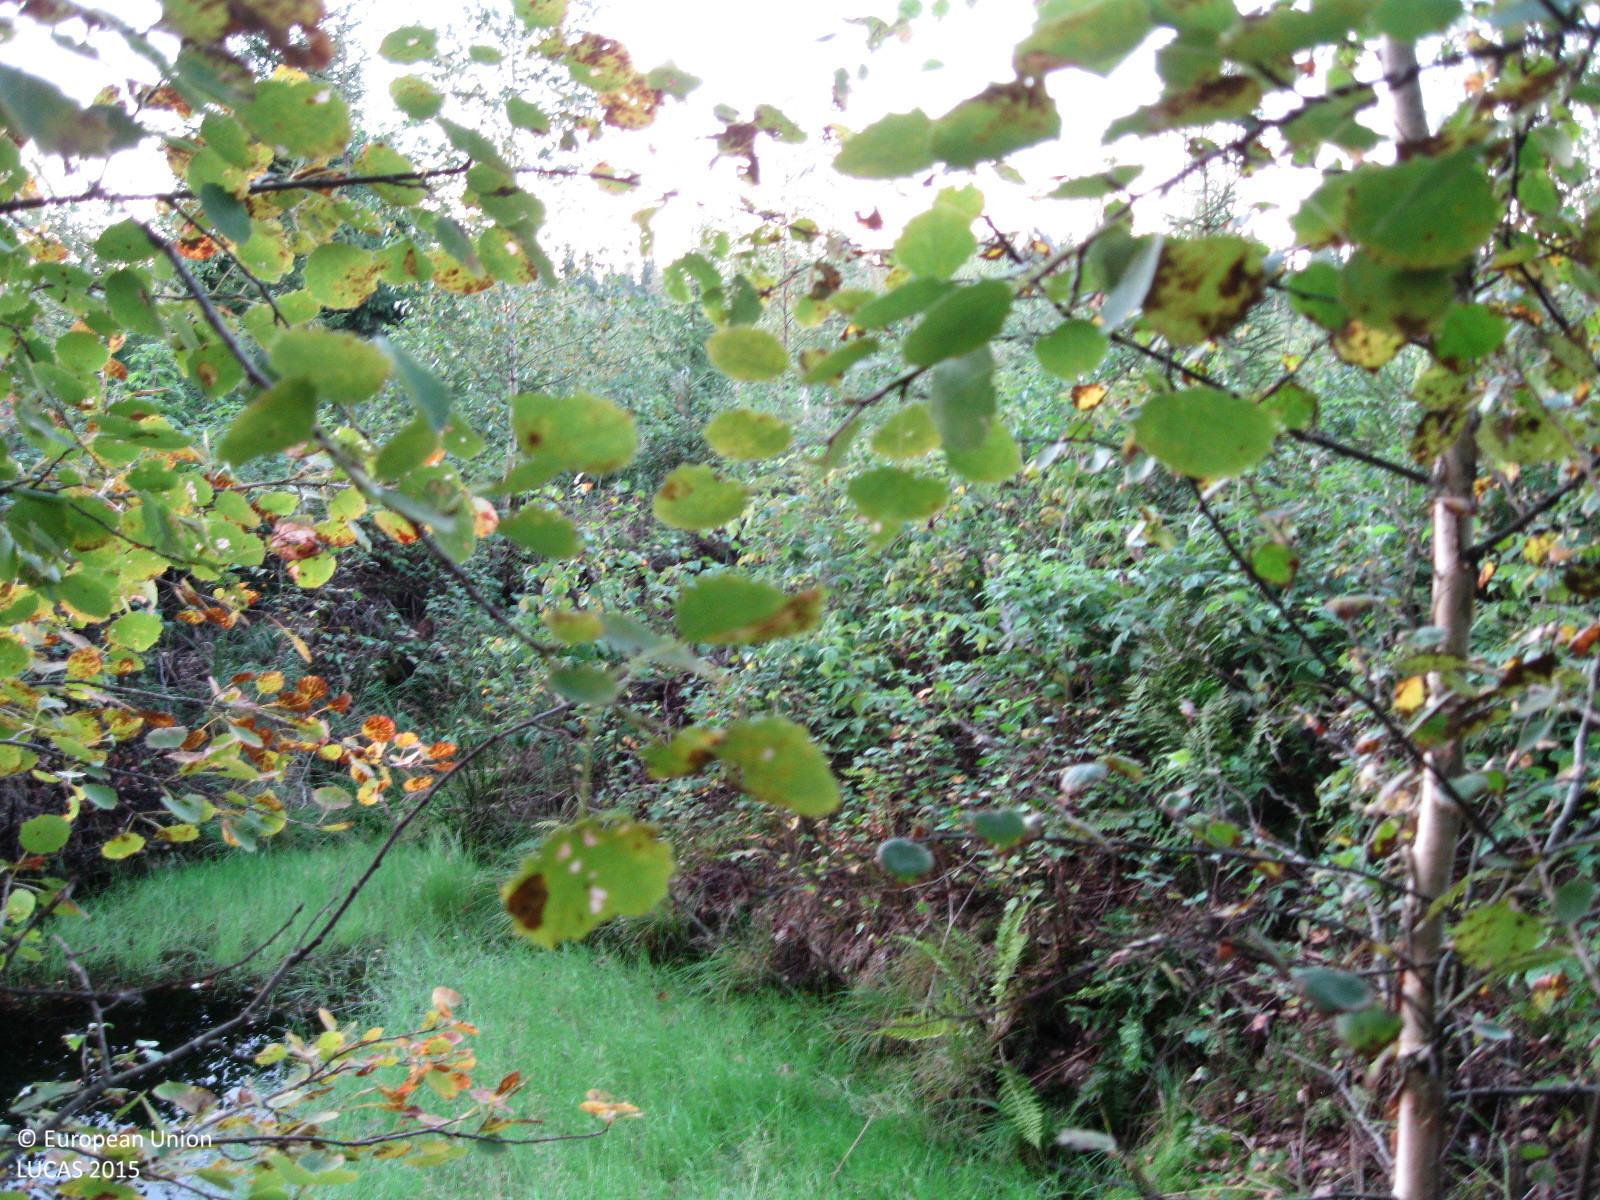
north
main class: Woodland
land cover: Spruce dominated mixed woodland
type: boreal forest
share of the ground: 50 - 75 %
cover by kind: coniferous forest trees 35 %, broadleaved forest trees 35 %, shrubs 25 %, herbaceous plants 5 %
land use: Forestry
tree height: < 5 m
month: September
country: FI
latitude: 60.6119
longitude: 24.7438
